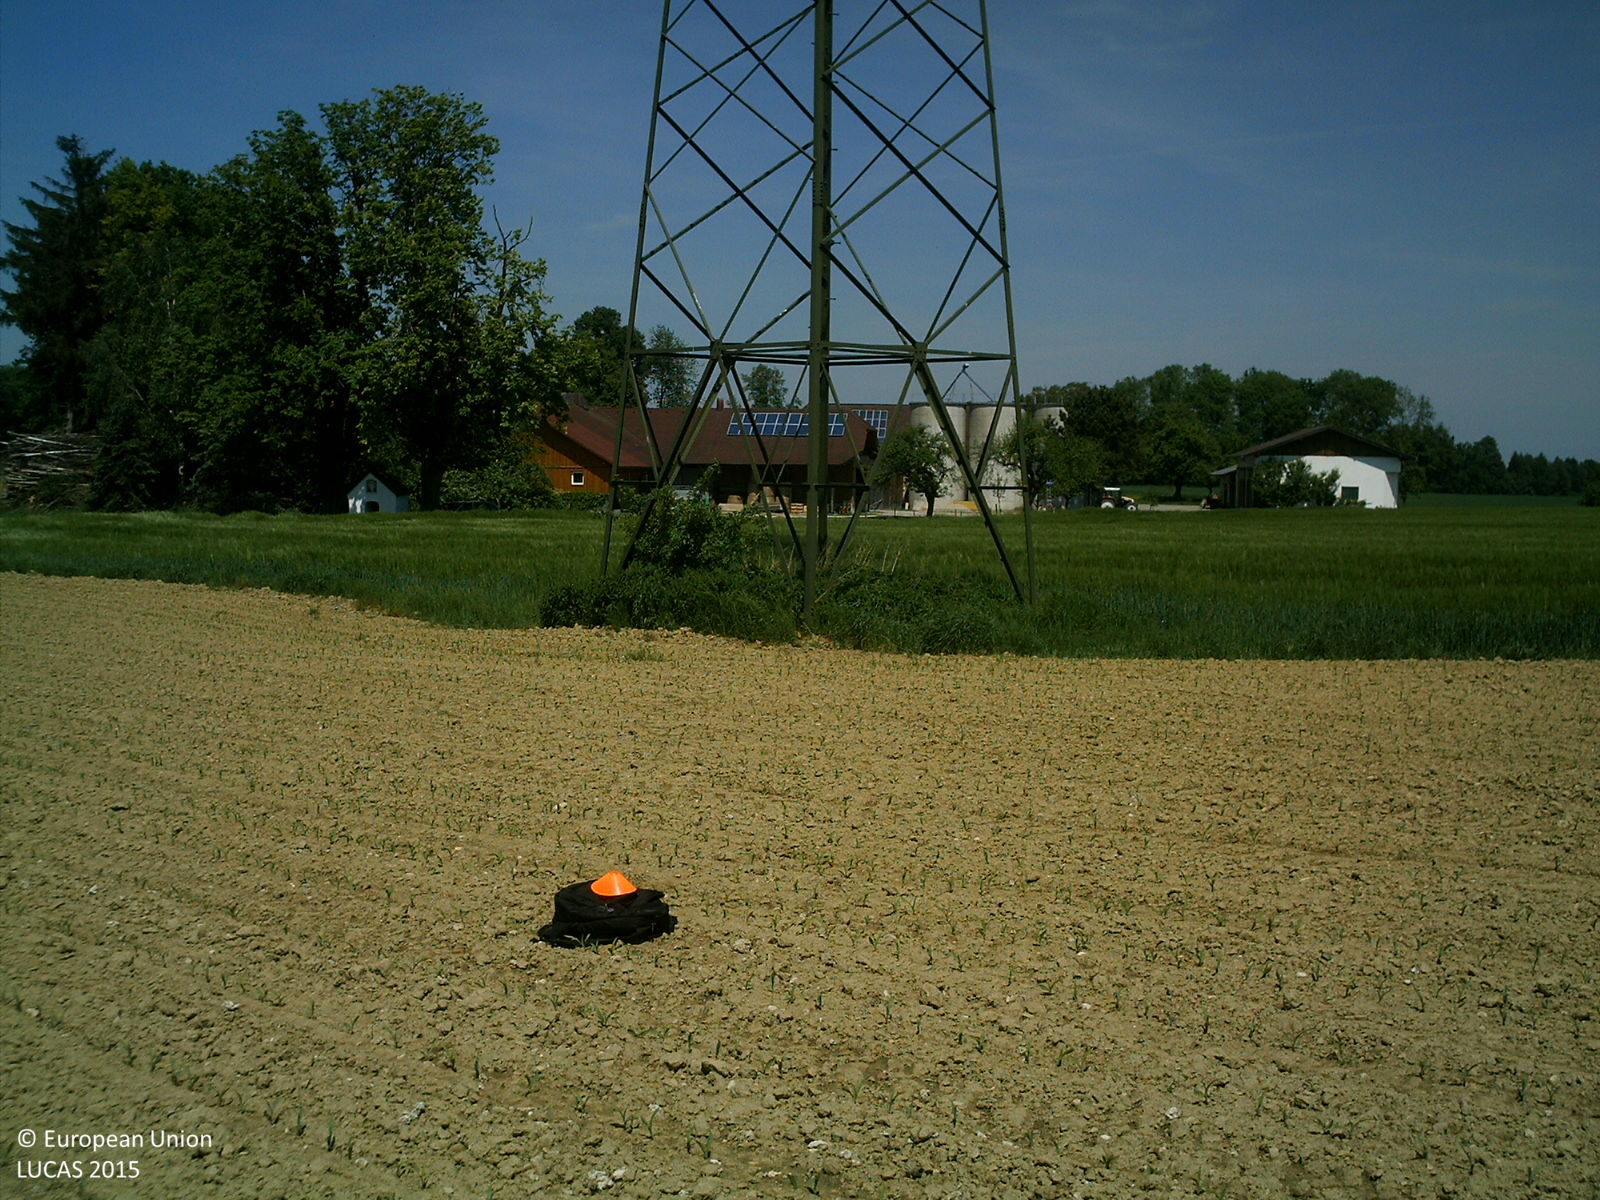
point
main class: Cropland
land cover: Maize
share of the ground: < 10 %
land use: Agriculture (excluding fallow land and kitchen gardens)
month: May
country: AT
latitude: 48.0056
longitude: 14.0341
